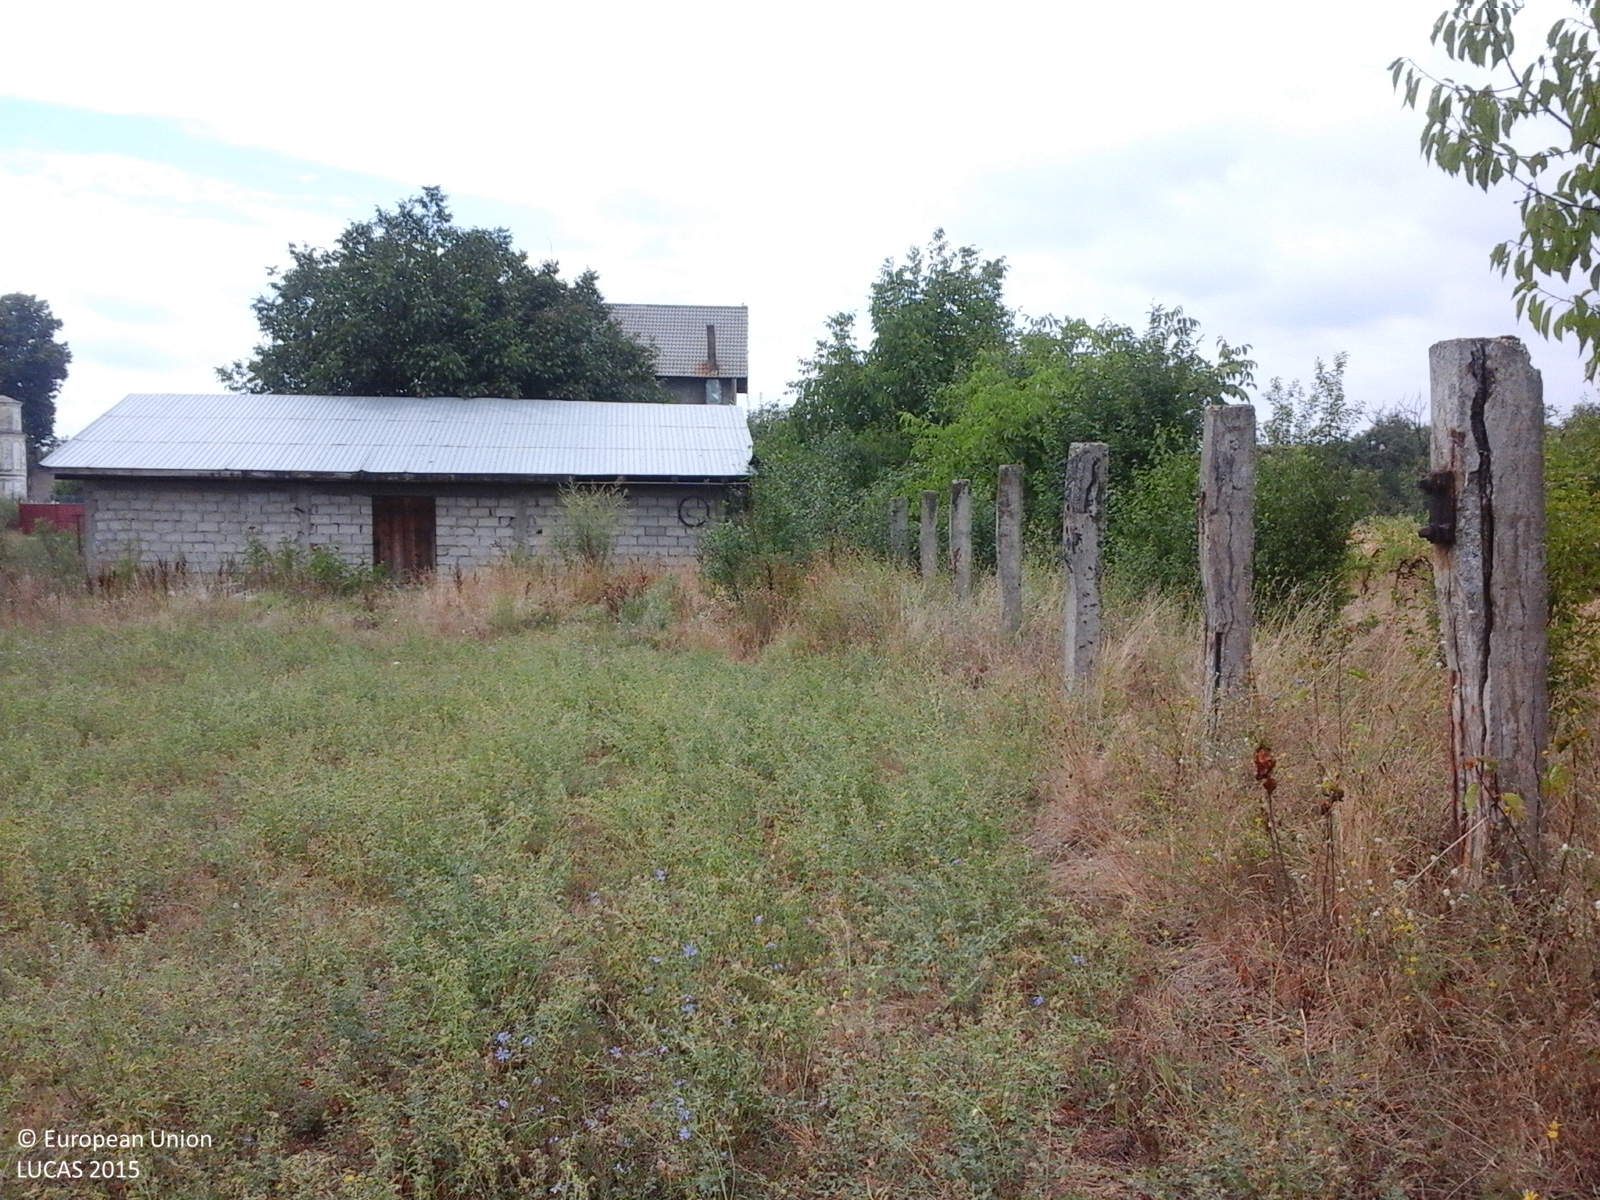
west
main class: Cropland
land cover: Lucerne
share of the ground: > 75 %
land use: Agriculture (excluding fallow land and kitchen gardens)
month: August
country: RO
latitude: 44.6412
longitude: 22.7128
